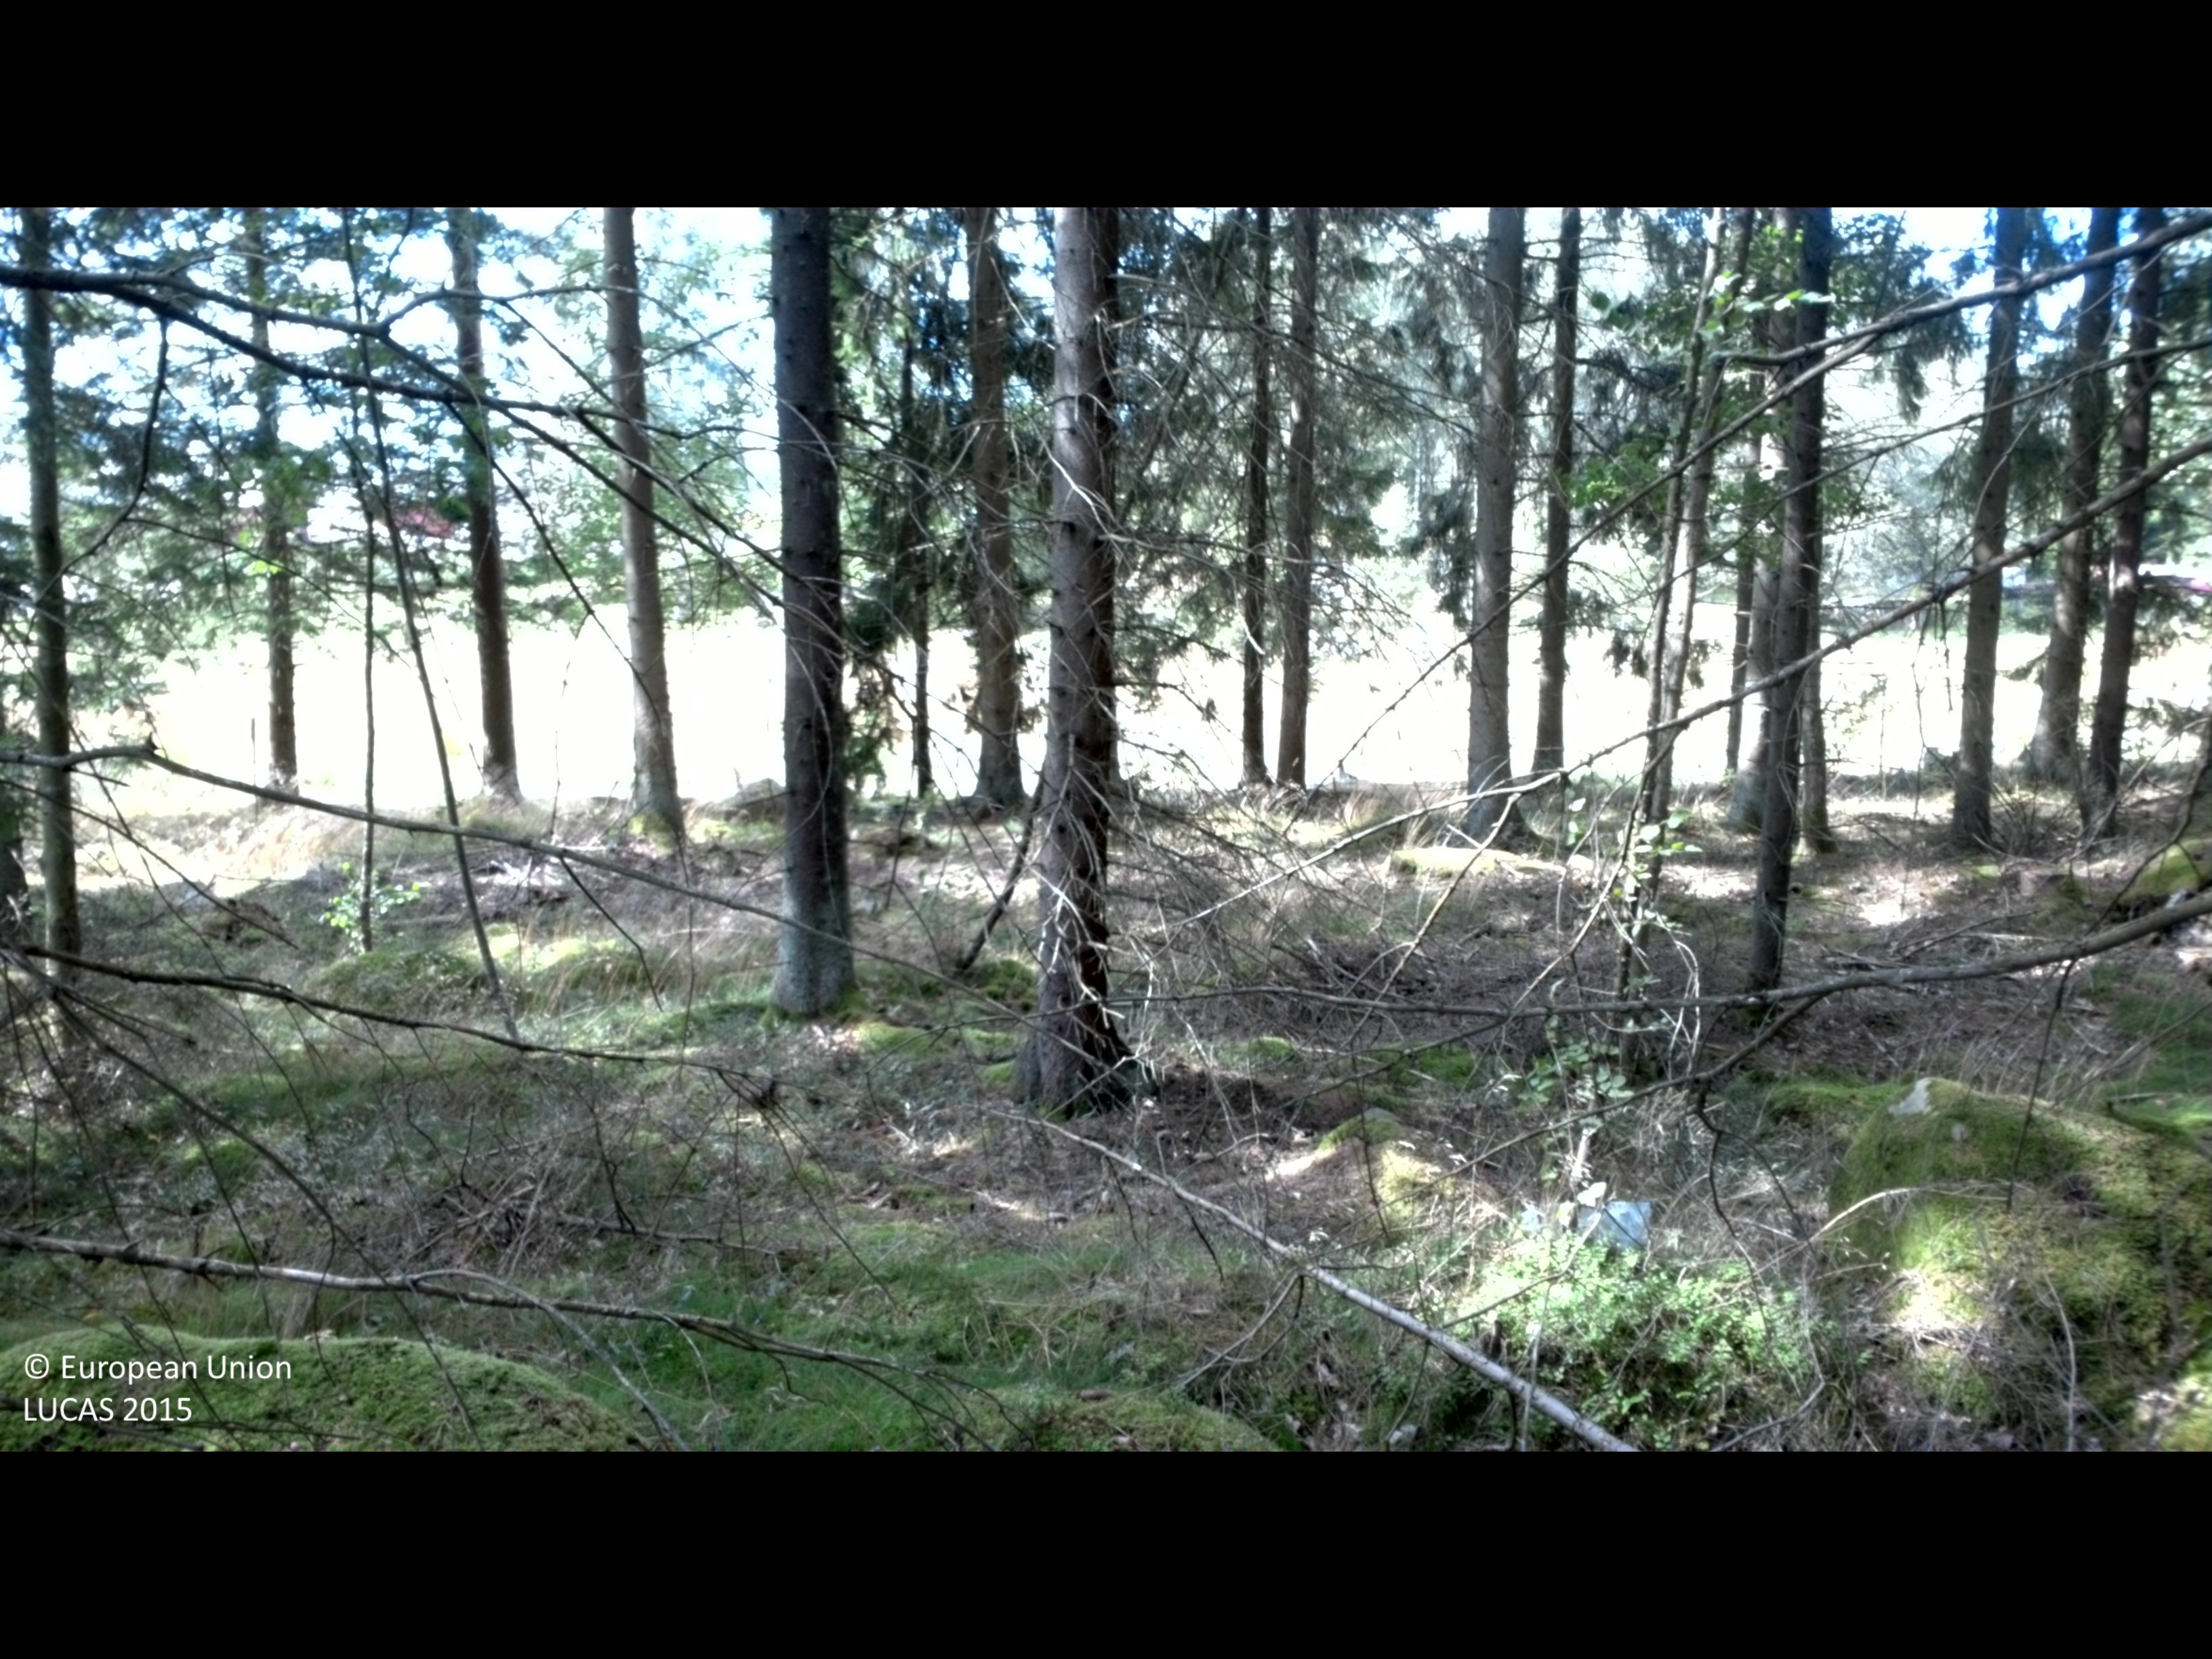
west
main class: Woodland
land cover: Spruce dominated coniferous woodland
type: boreal forest
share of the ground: > 75 %
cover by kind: coniferous forest trees 75 %, lichens and mosses 15 %
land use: Forestry
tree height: > 5 m
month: August
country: SE
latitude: 56.3492
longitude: 14.3179
